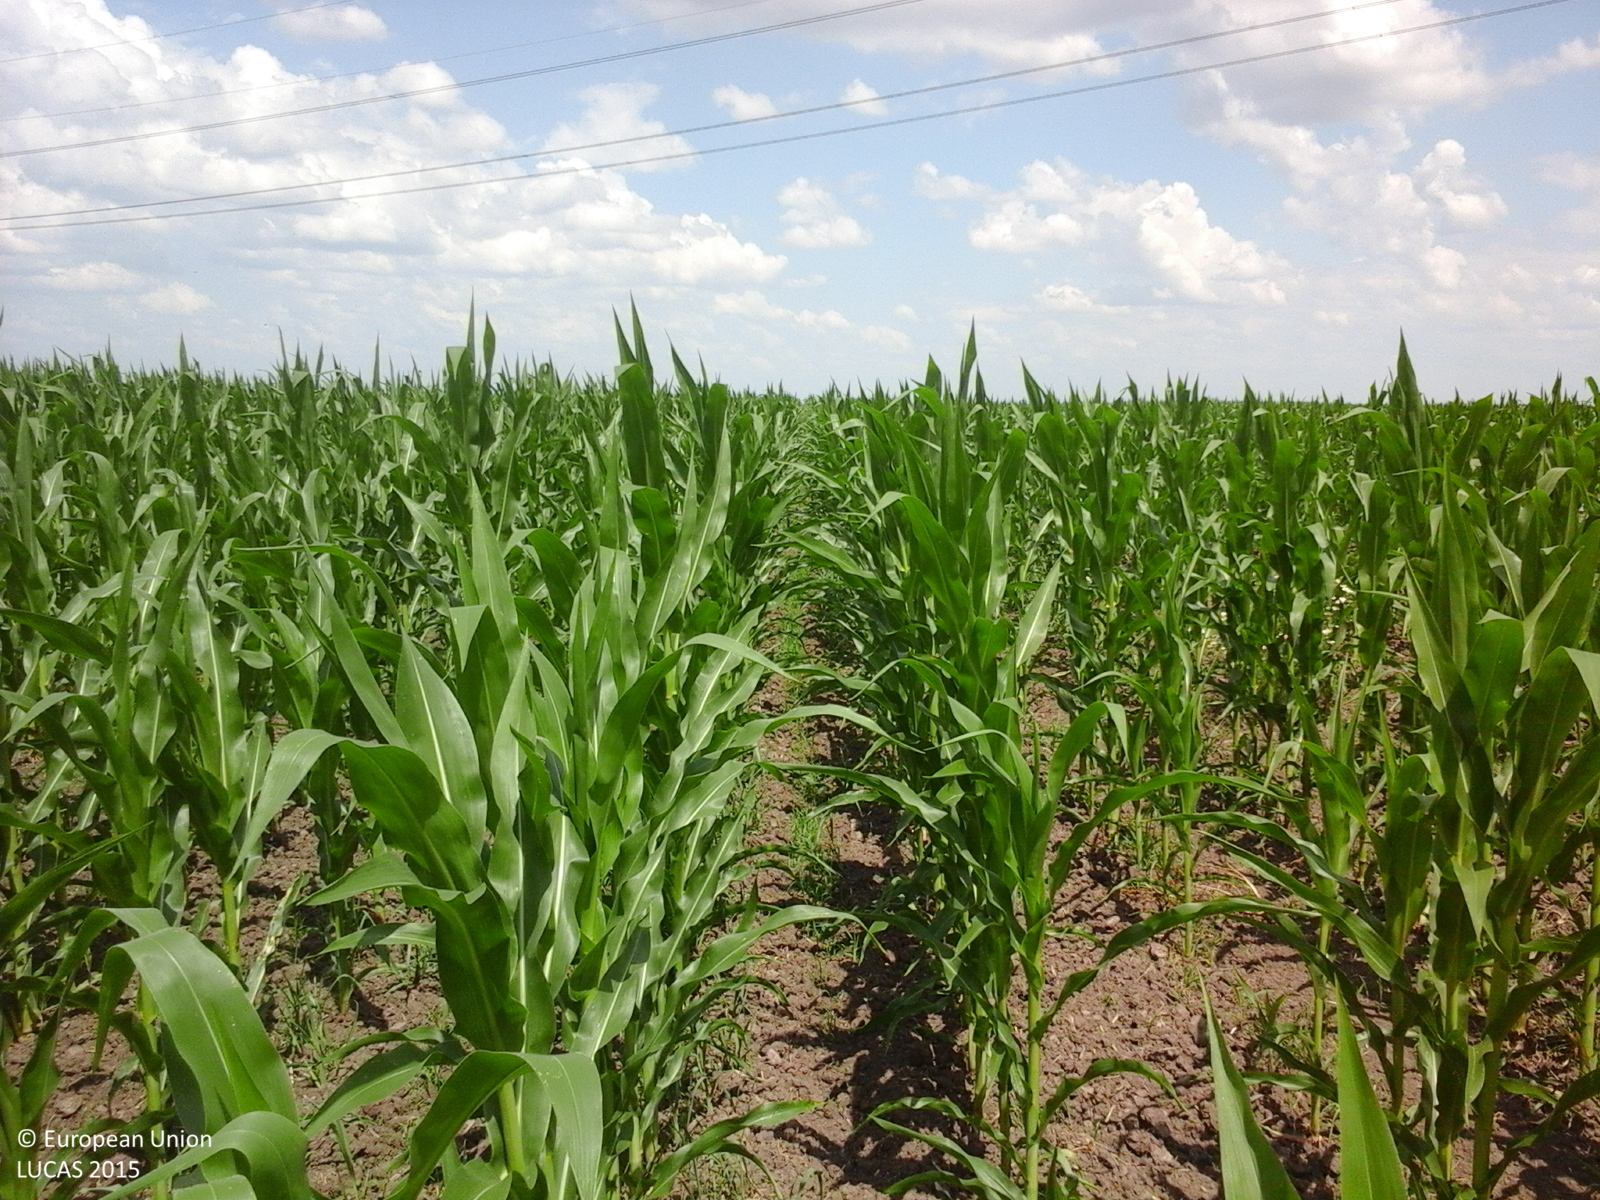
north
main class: Cropland
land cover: Maize
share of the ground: > 75 %
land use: Agriculture (excluding fallow land and kitchen gardens)
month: July
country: RO
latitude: 44.2554
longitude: 25.4050
